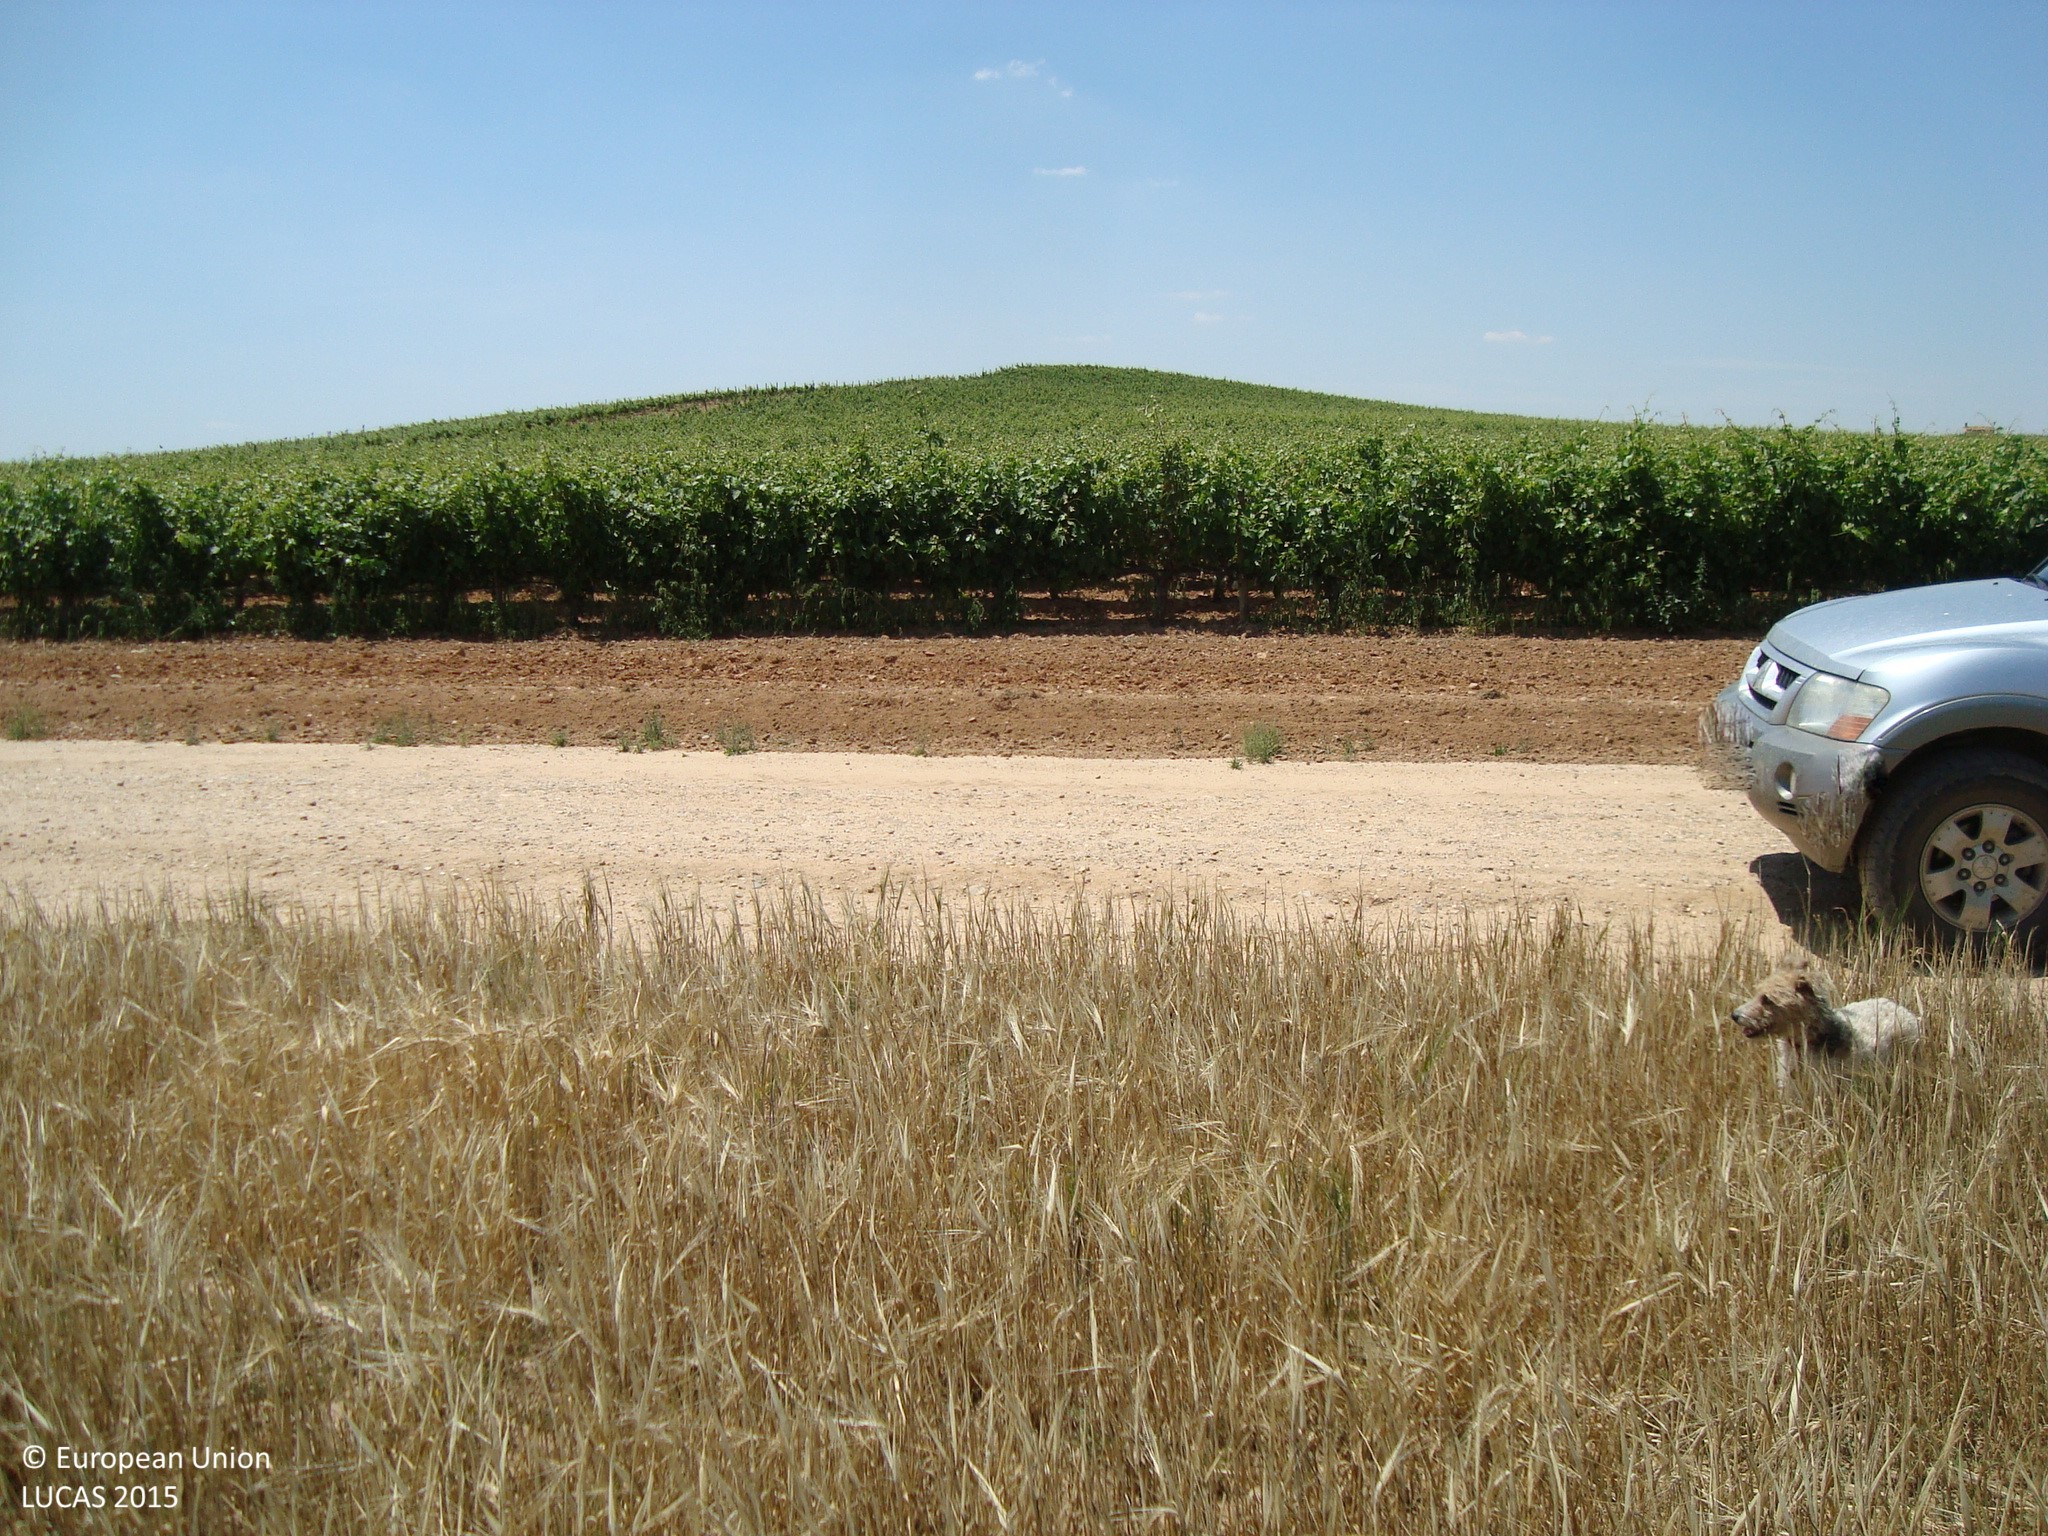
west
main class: Cropland
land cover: Barley
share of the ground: > 75 %
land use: Agriculture (excluding fallow land and kitchen gardens)
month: June
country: ES
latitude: 41.7167
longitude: -3.8421
